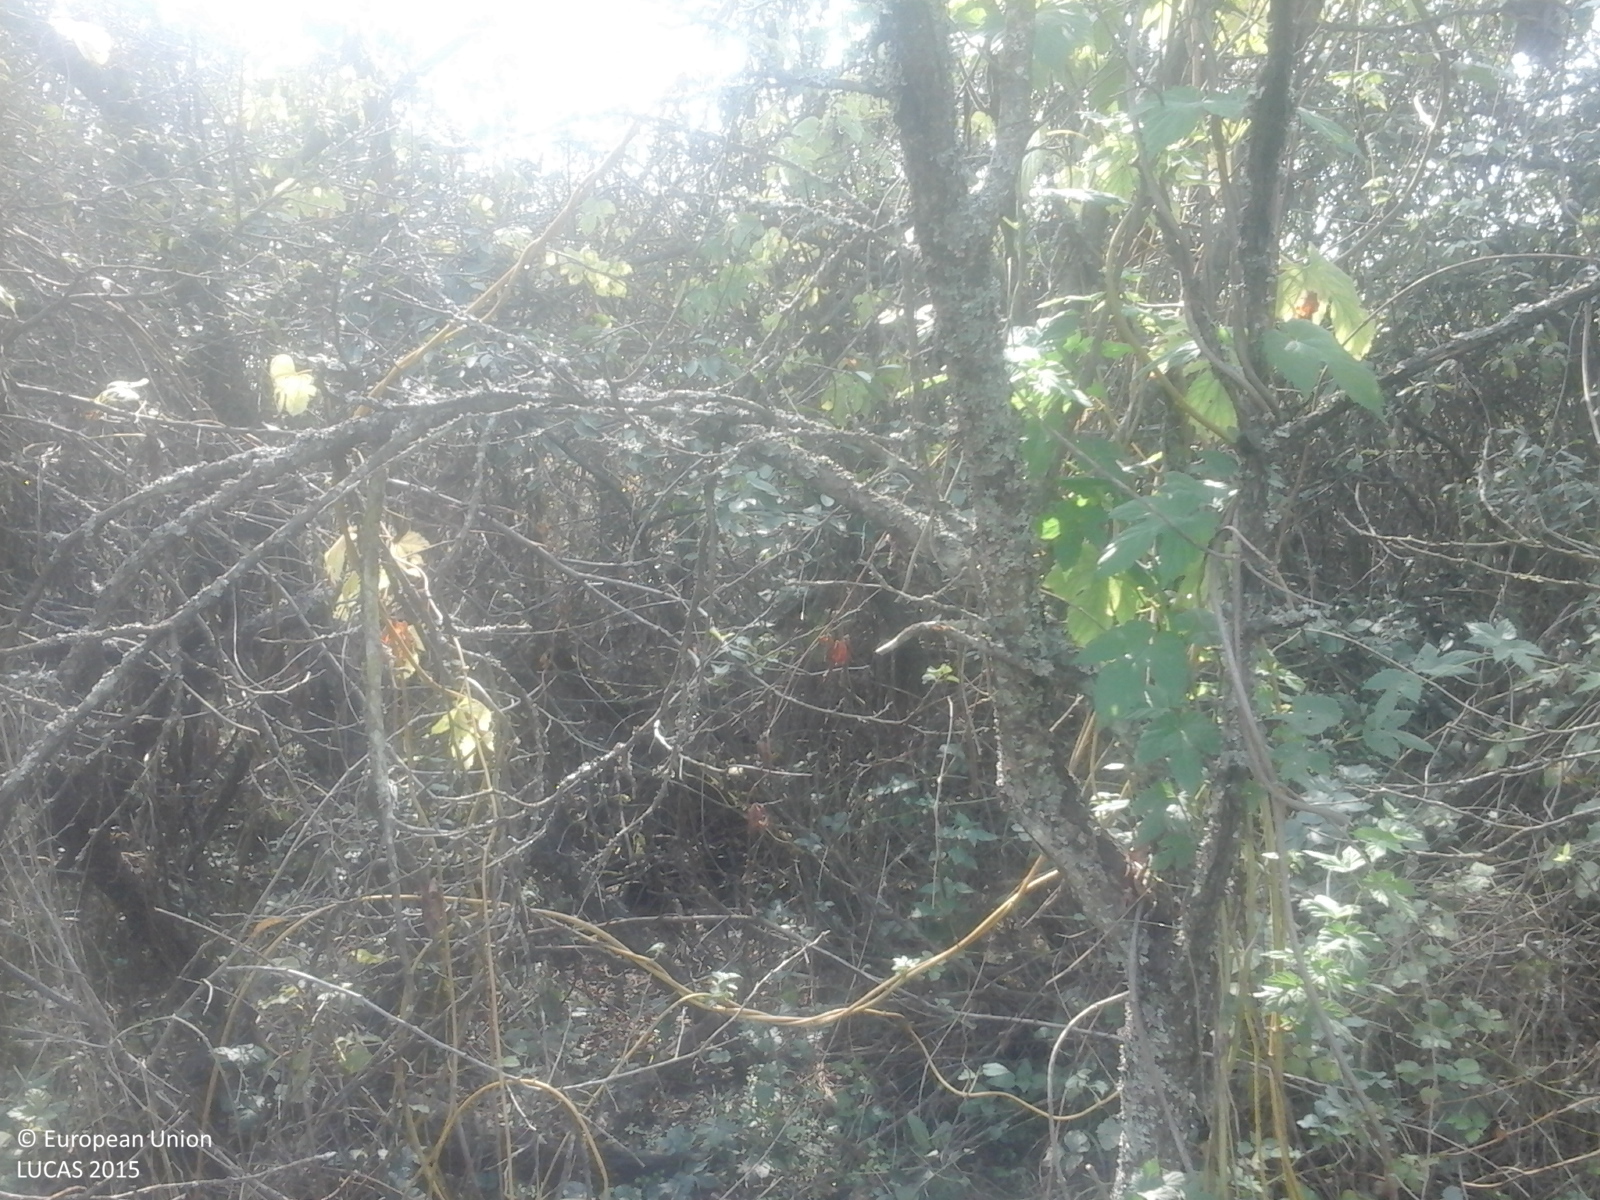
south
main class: Shrubland
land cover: Shrubland with sparse tree cover
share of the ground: > 75 %
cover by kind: shrubs 95 %, broadleaved forest trees 5 %
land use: Forestry
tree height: < 5 m
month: September
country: RO
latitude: 45.8191
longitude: 22.1537
